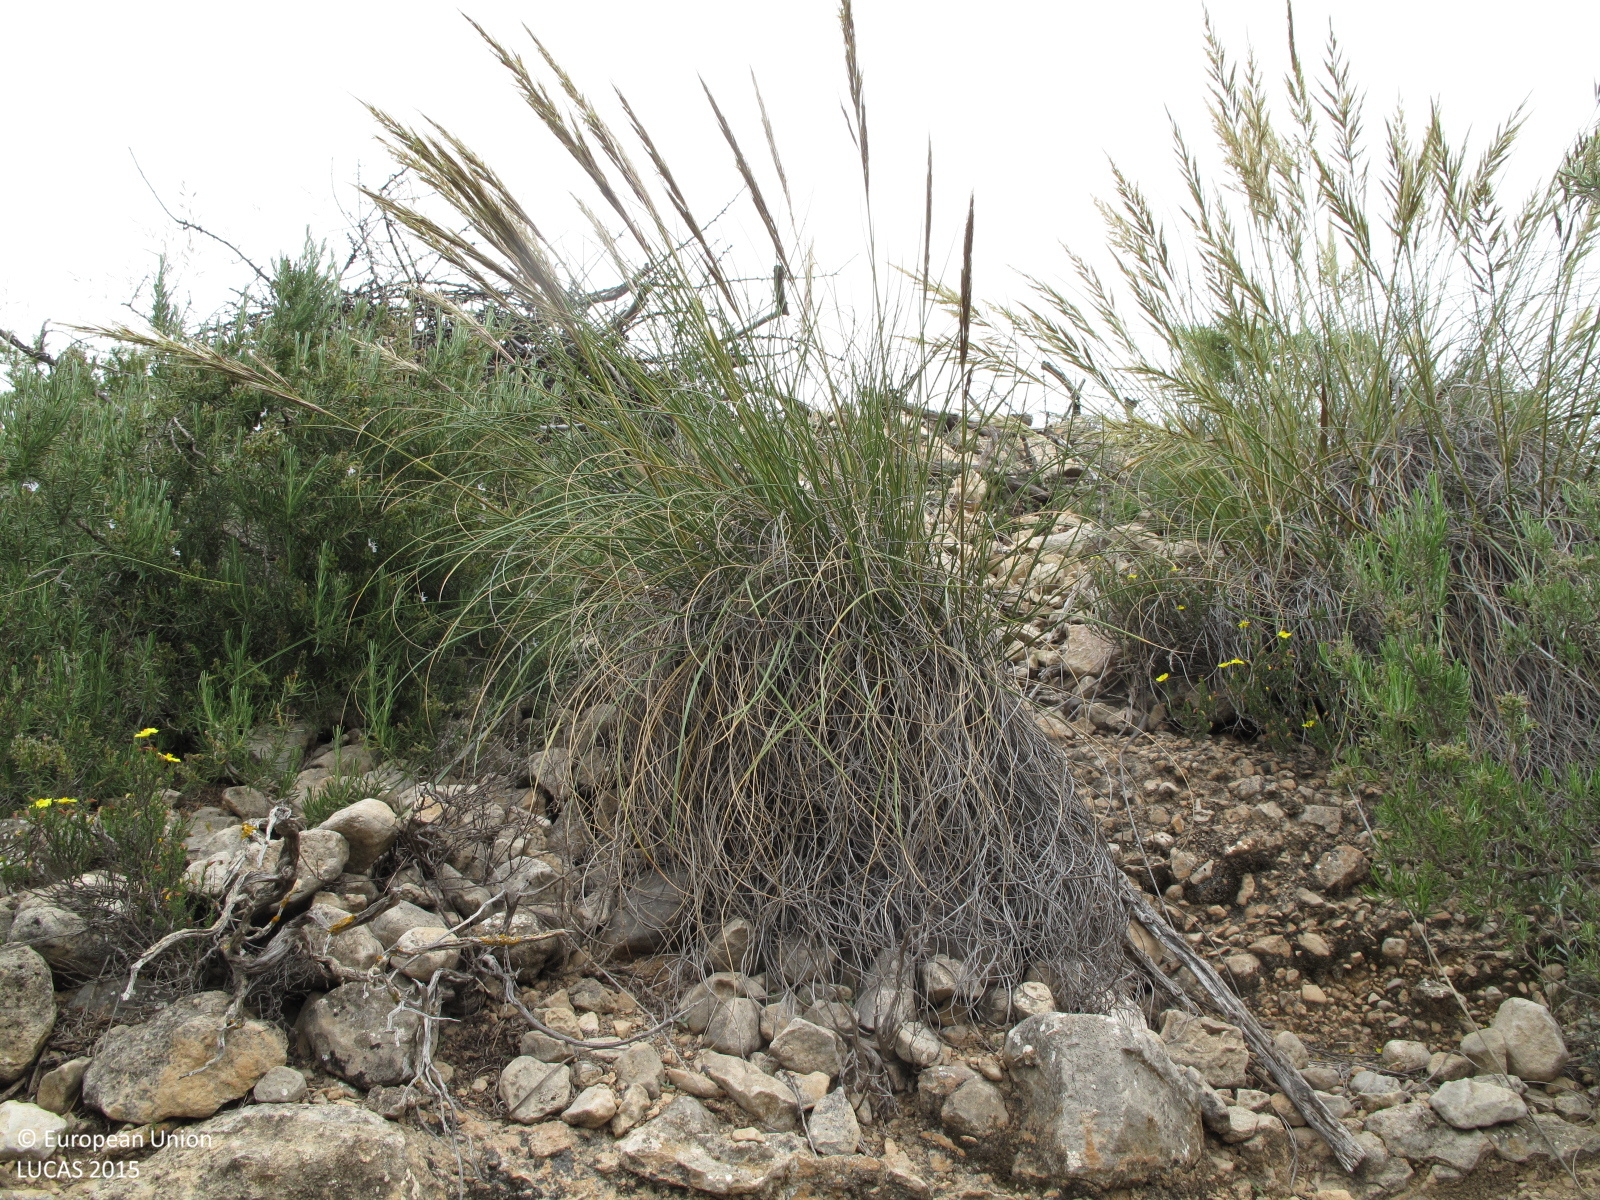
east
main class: Woodland
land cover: Other coniferous woodland
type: coniferous forest of the mediterranean region
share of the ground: 25 - 50 %
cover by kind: coniferous forest trees 45 %, shrubs 20 %, consolidated bare surface 20 %, herbaceous plants 15 %
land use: Semi-natural and natural areas not in use
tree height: > 5 m
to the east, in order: Other coniferous woodland; Nuts trees; Tracks; Pine dominated coniferous woodland; Tracks; Pine dominated coniferous woodland; Tracks; Pine dominated coniferous woodland
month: April
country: ES
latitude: 38.5035
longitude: -0.9400
